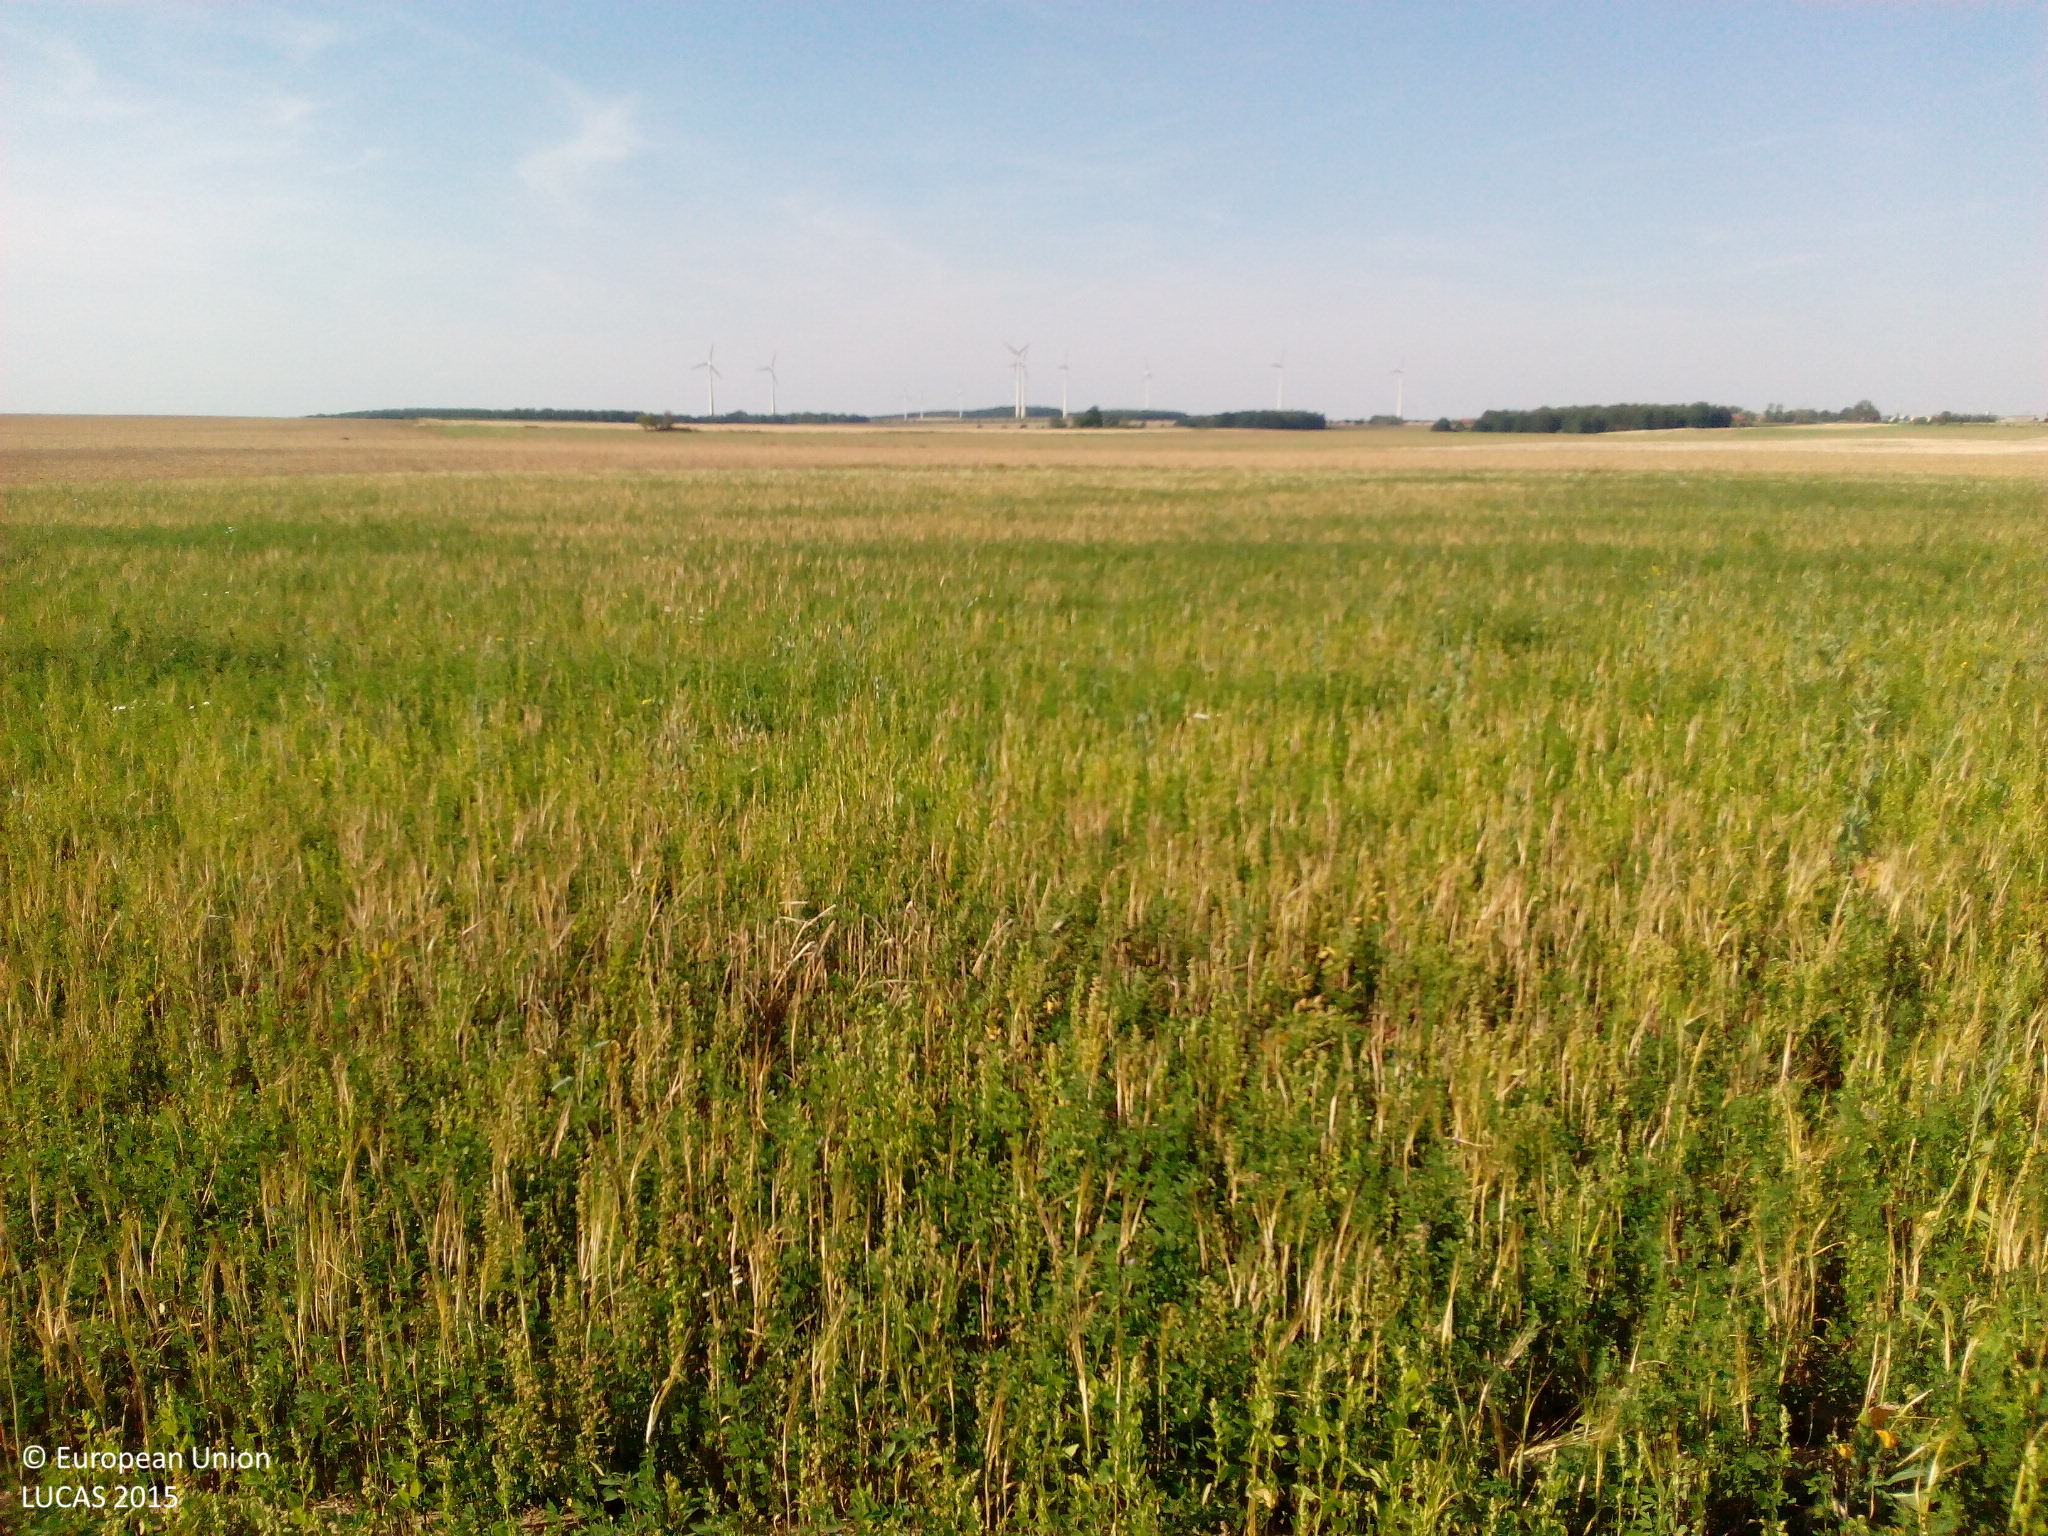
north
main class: Cropland
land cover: Barley
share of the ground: 10 - 25 %
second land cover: Clovers
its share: 50 - 75 %
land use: Agriculture (excluding fallow land and kitchen gardens)
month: August
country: DE
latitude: 51.9406
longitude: 13.1275
